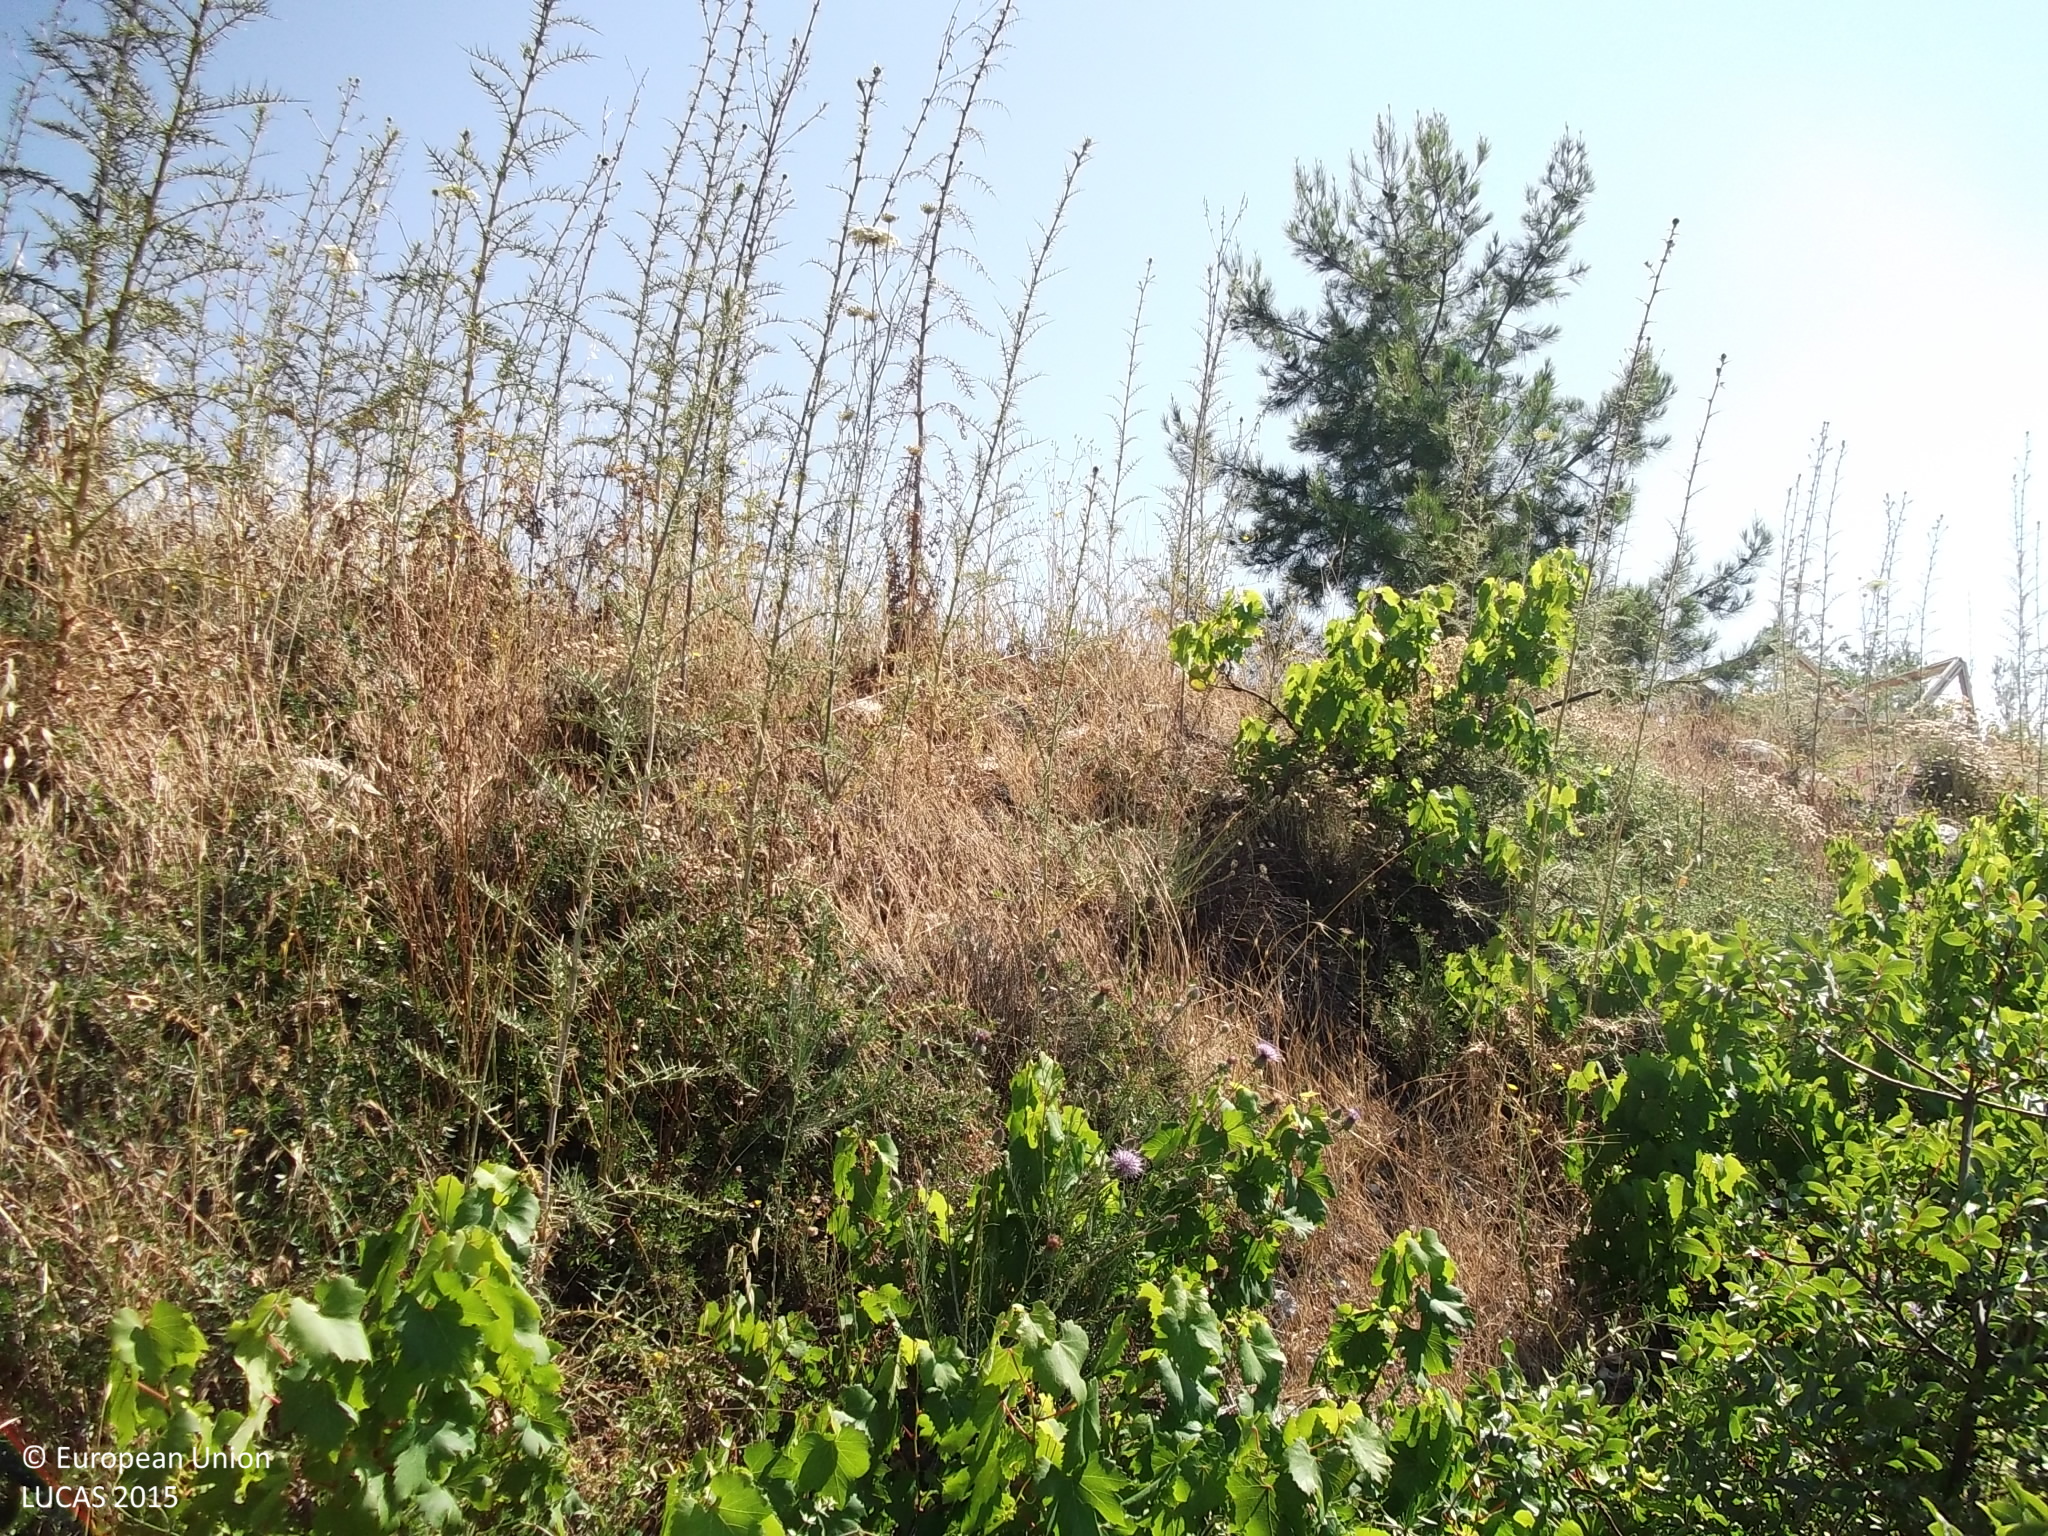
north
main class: Woodland
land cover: Pine dominated coniferous woodland
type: coniferous forest of the mediterranean region
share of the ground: 10 - 25 %
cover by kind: unconsolidated bare surface 35 %, coniferous forest trees 25 %, shrubs 20 %, herbaceous plants 20 %
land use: Semi-natural and natural areas not in use
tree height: > 5 m
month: June
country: CY
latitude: 34.8451
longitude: 32.9467
